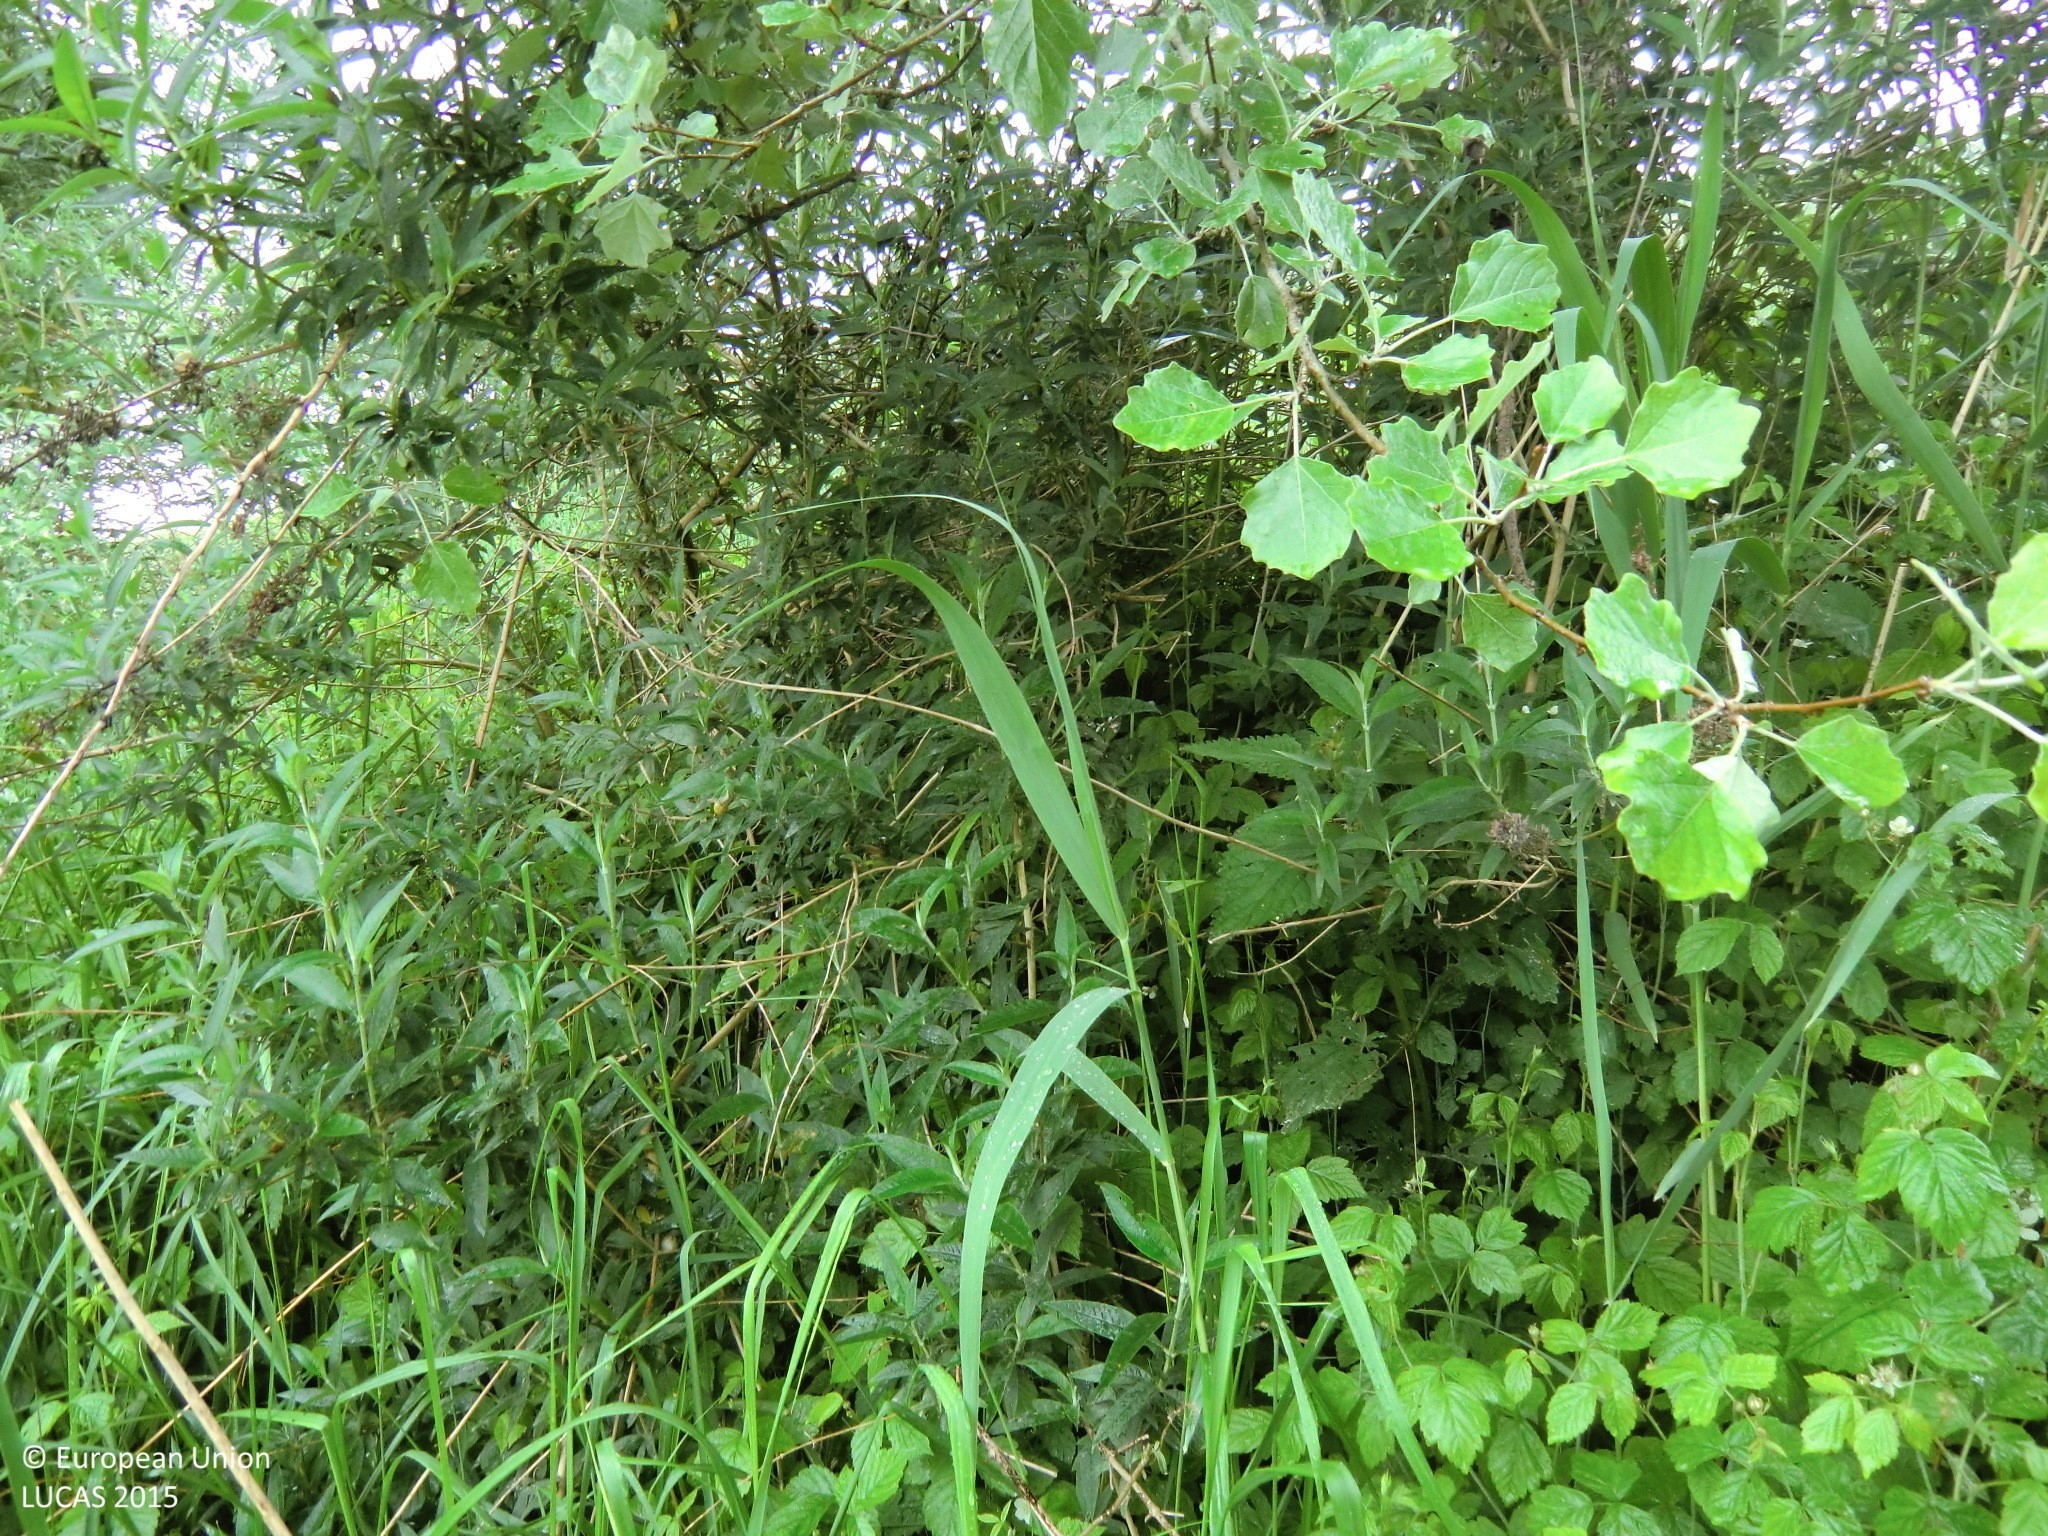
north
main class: Grassland
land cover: Grassland with sparse tree/shrub cover
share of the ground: > 75 %
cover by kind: herbaceous plants 95 %, broadleaved forest trees 5 %
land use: Semi-natural and natural areas not in use
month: May
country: AT
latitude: 48.2617
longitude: 14.4052
